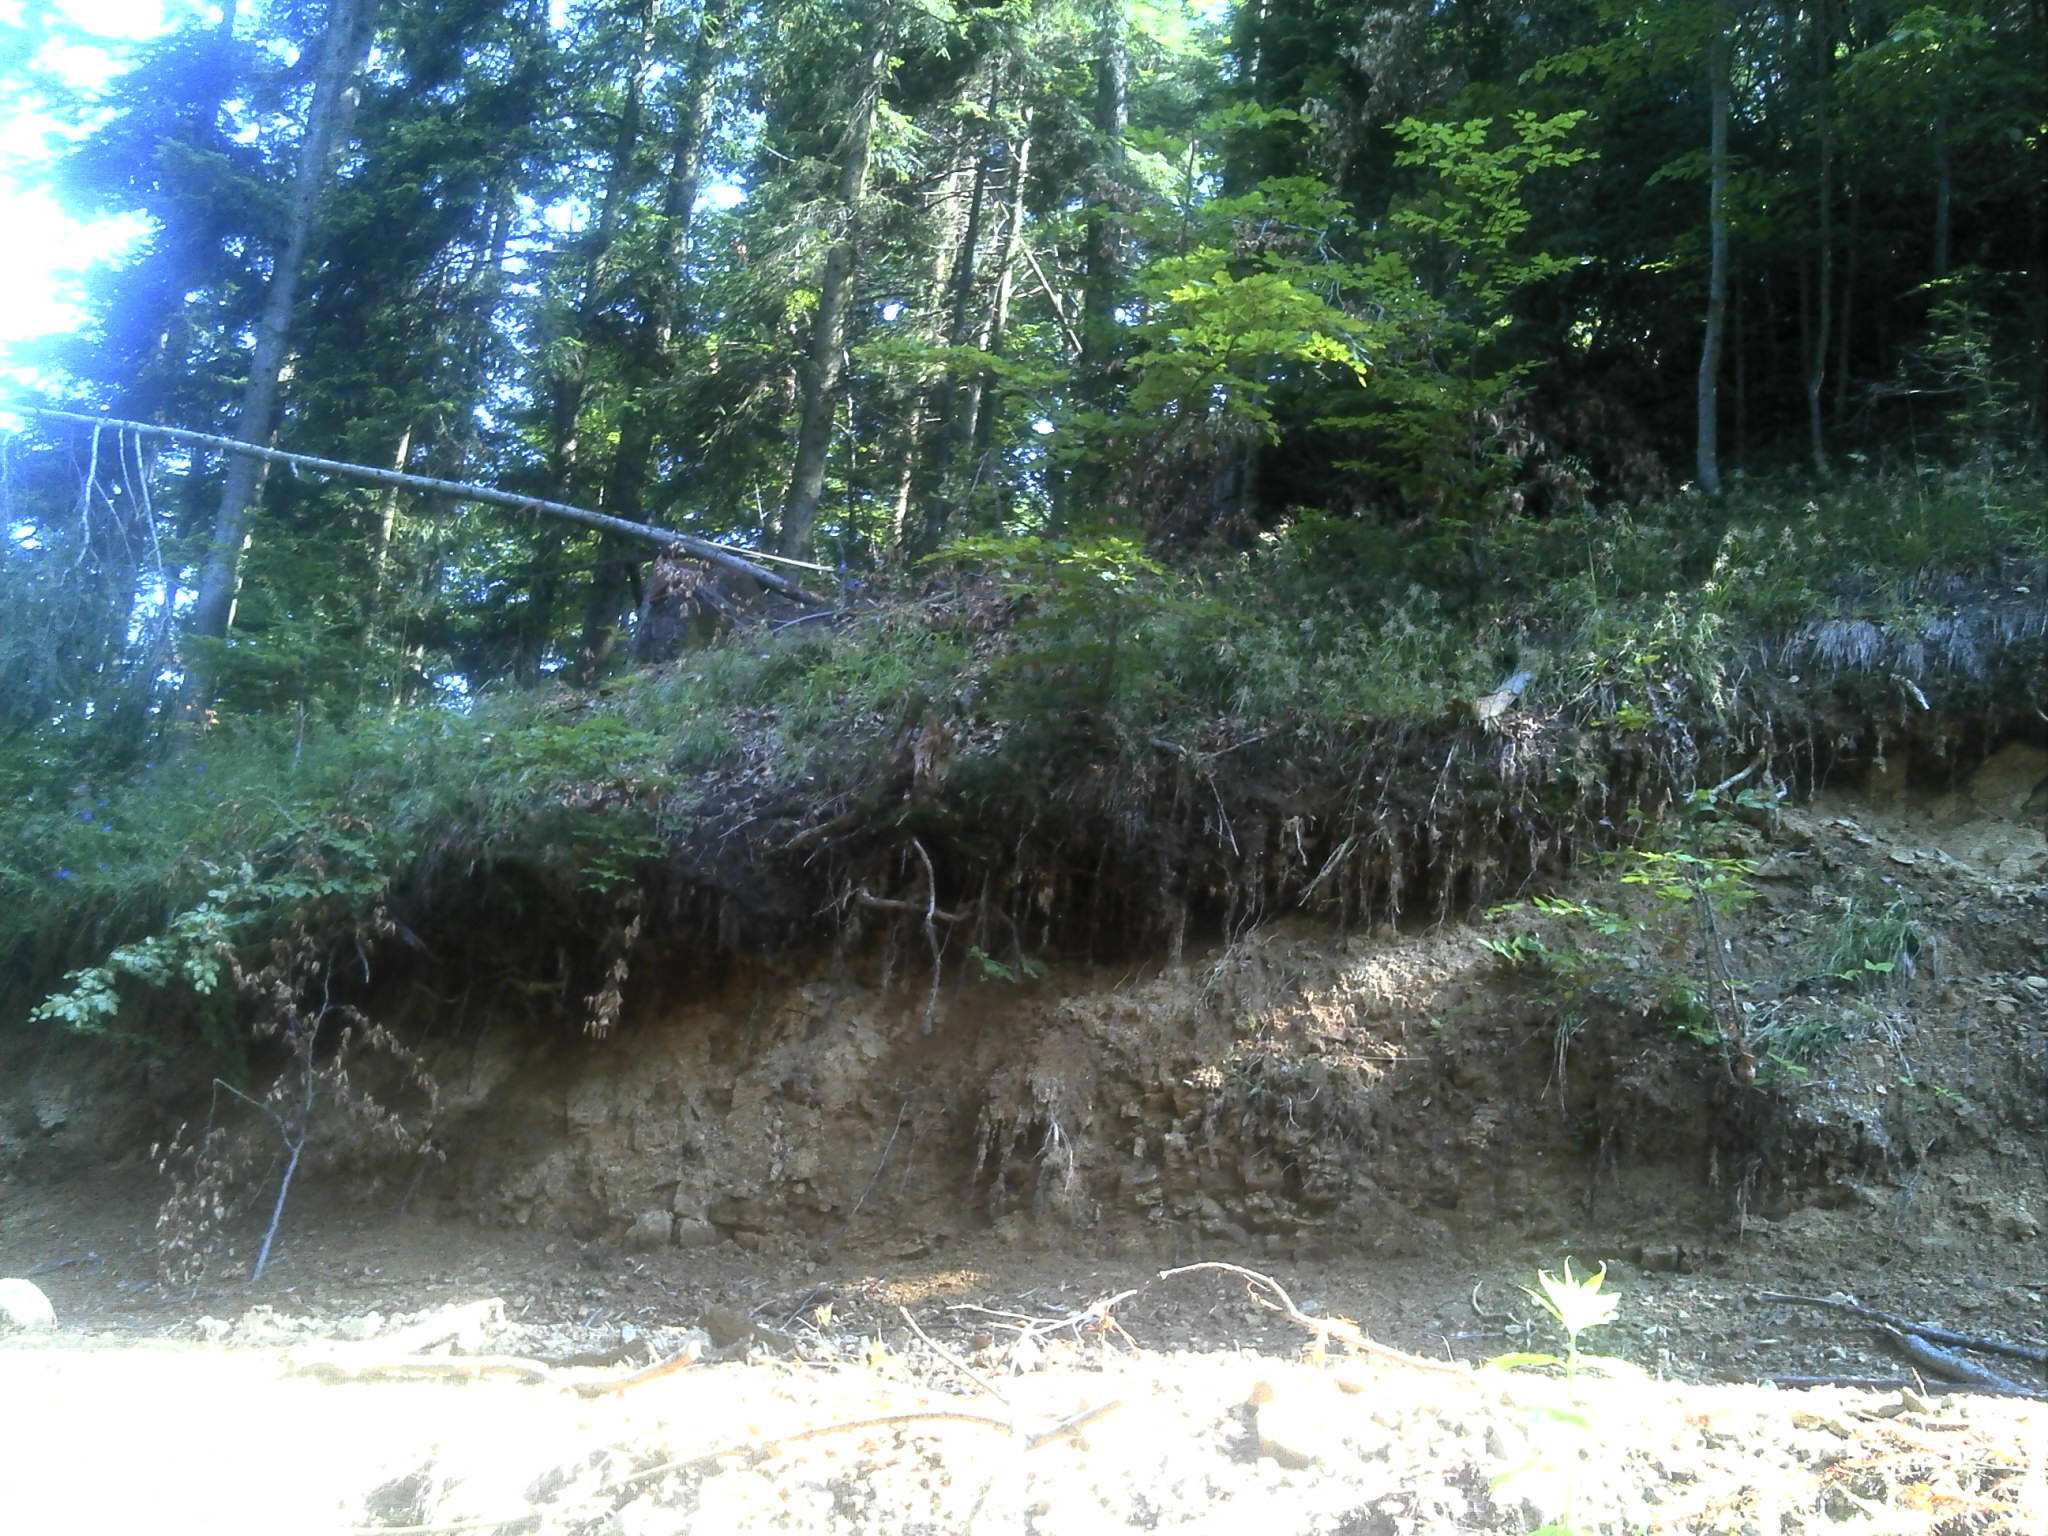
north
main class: Woodland
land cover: Pine dominated mixed woodland
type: coniferous forest of the mediterranean region
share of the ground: > 75 %
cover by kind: coniferous forest trees 70 %, broadleaved forest trees 30 %
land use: Forestry
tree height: > 5 m
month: June
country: HR
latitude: 45.5812
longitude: 17.4992
